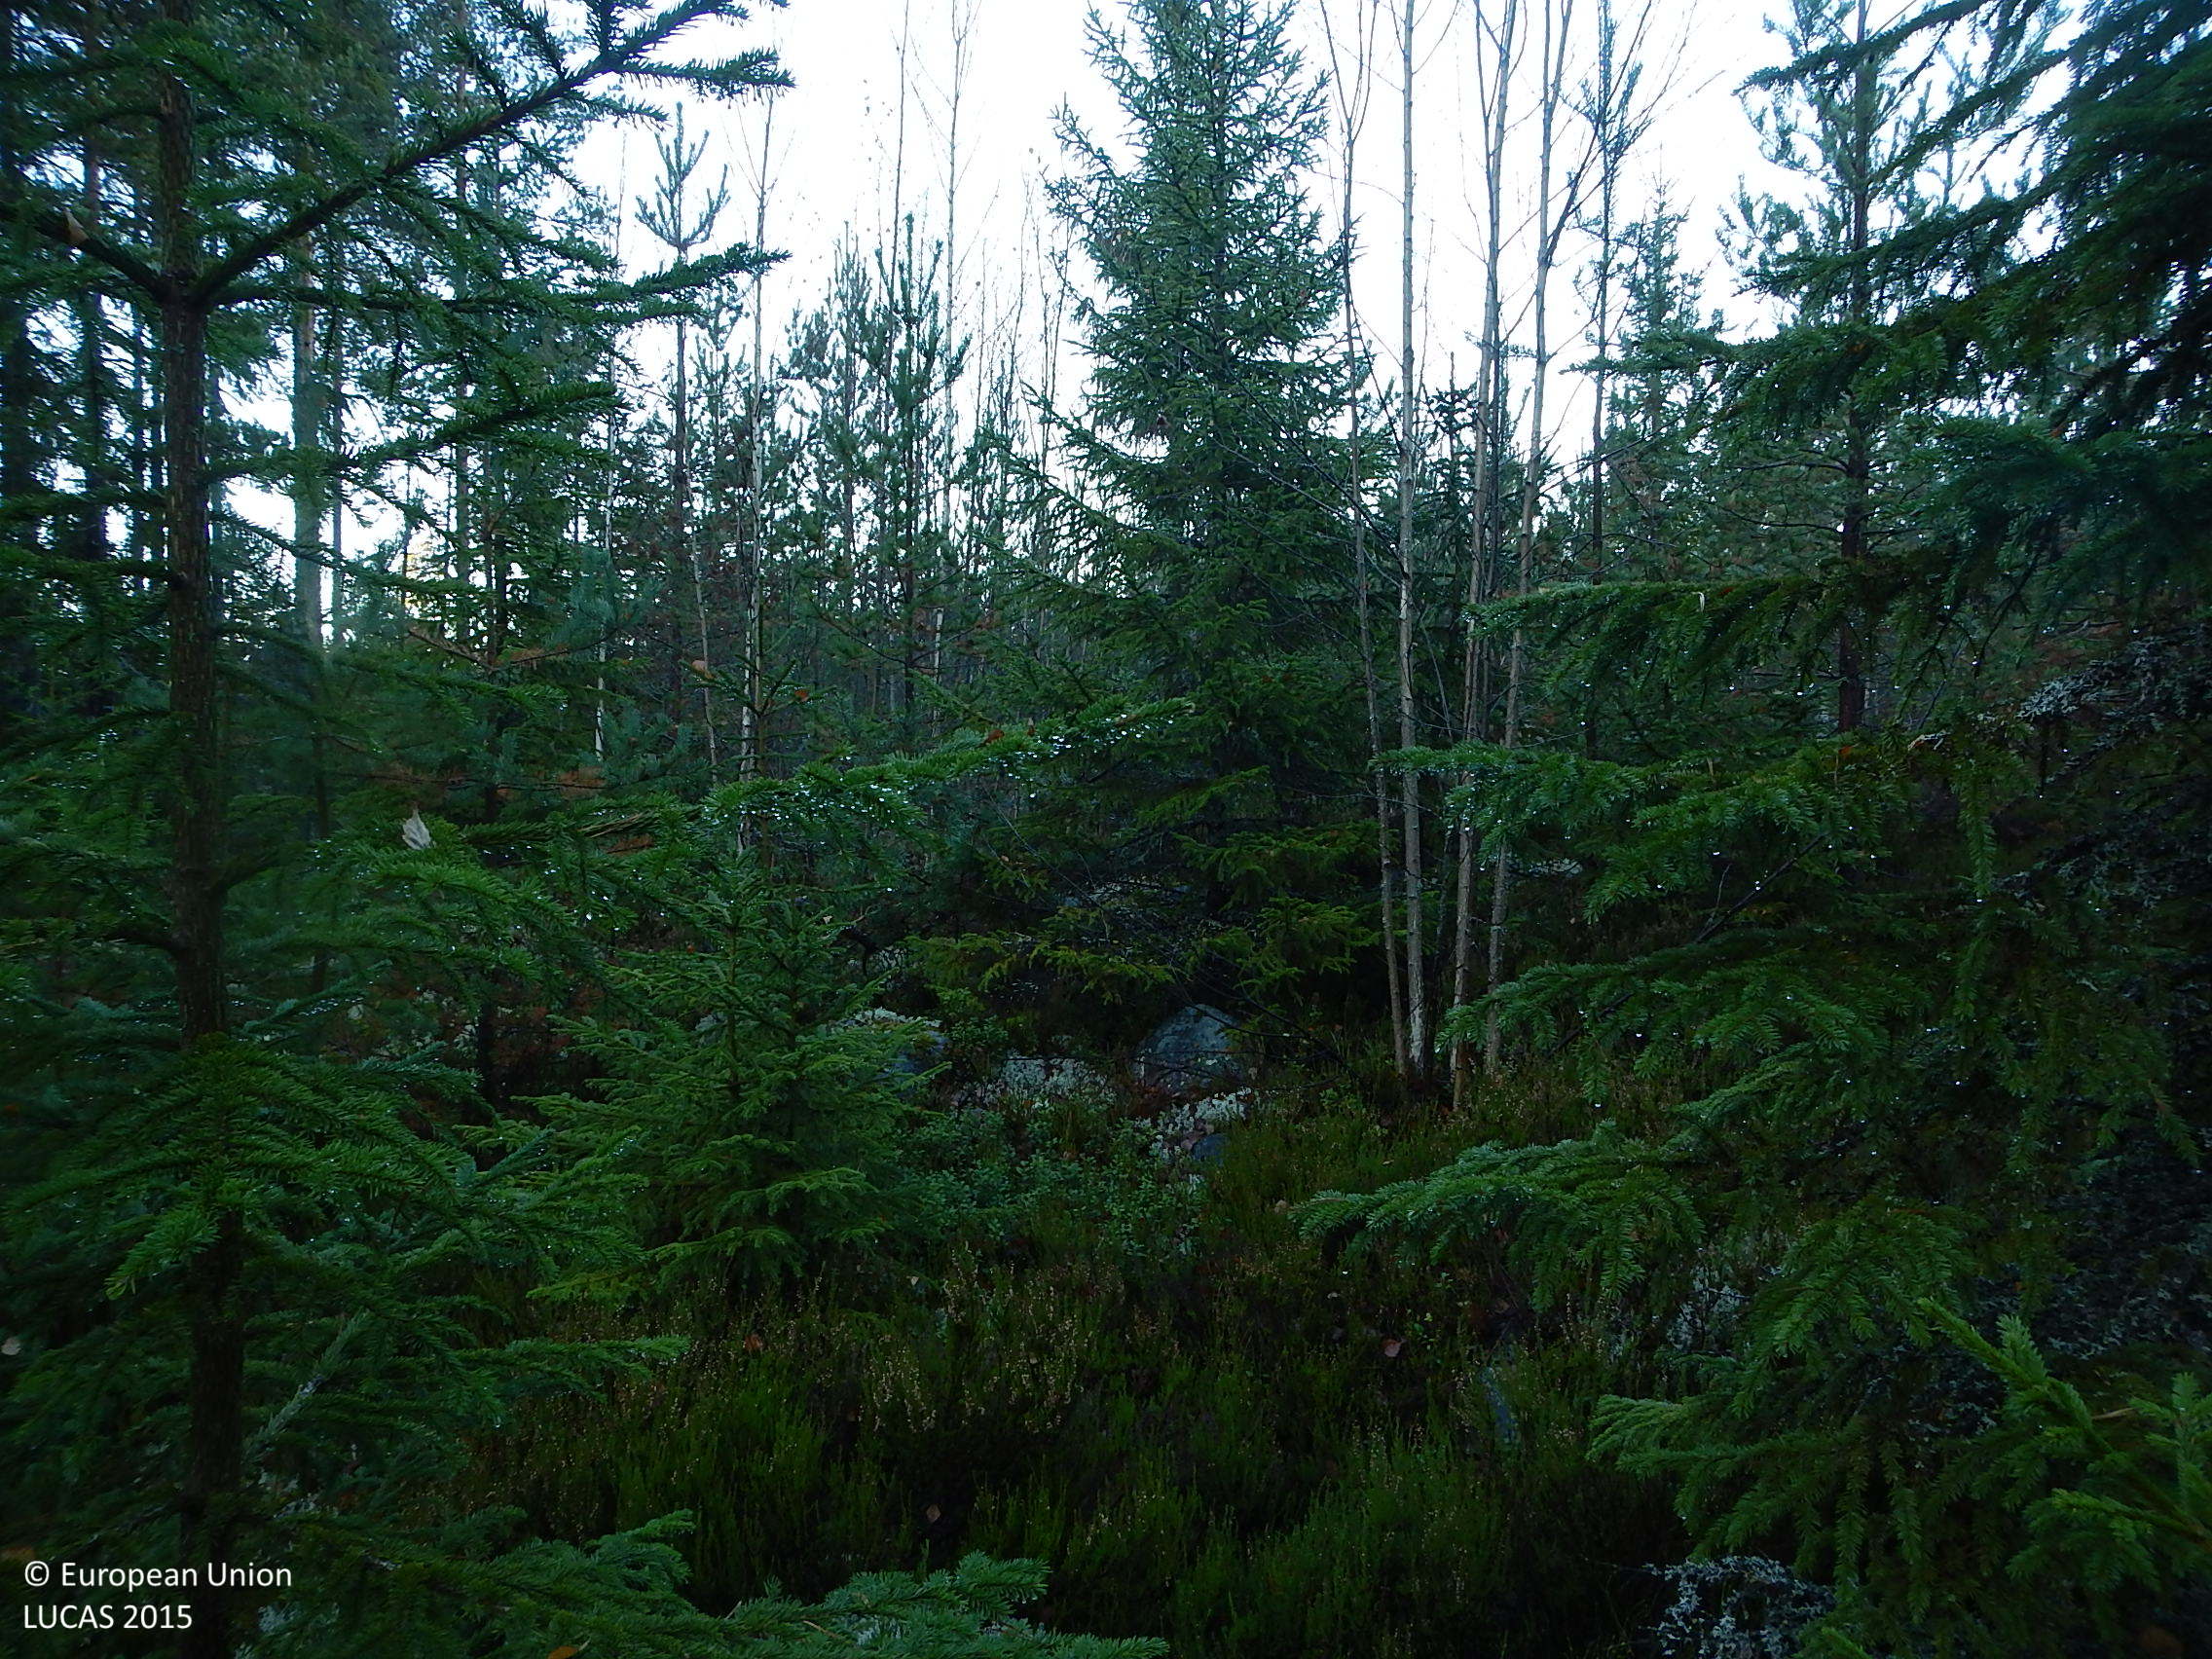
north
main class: Woodland
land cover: Other mixed woodland
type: boreal forest
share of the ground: 50 - 75 %
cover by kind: coniferous forest trees 40 %, shrubs 25 %, broadleaved forest trees 20 %, consolidated bare surface 10 %, lichens and mosses 5 %
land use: Forestry
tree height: > 5 m
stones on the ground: 10 - 25 %
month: November
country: SE
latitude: 61.2005
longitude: 17.0015
